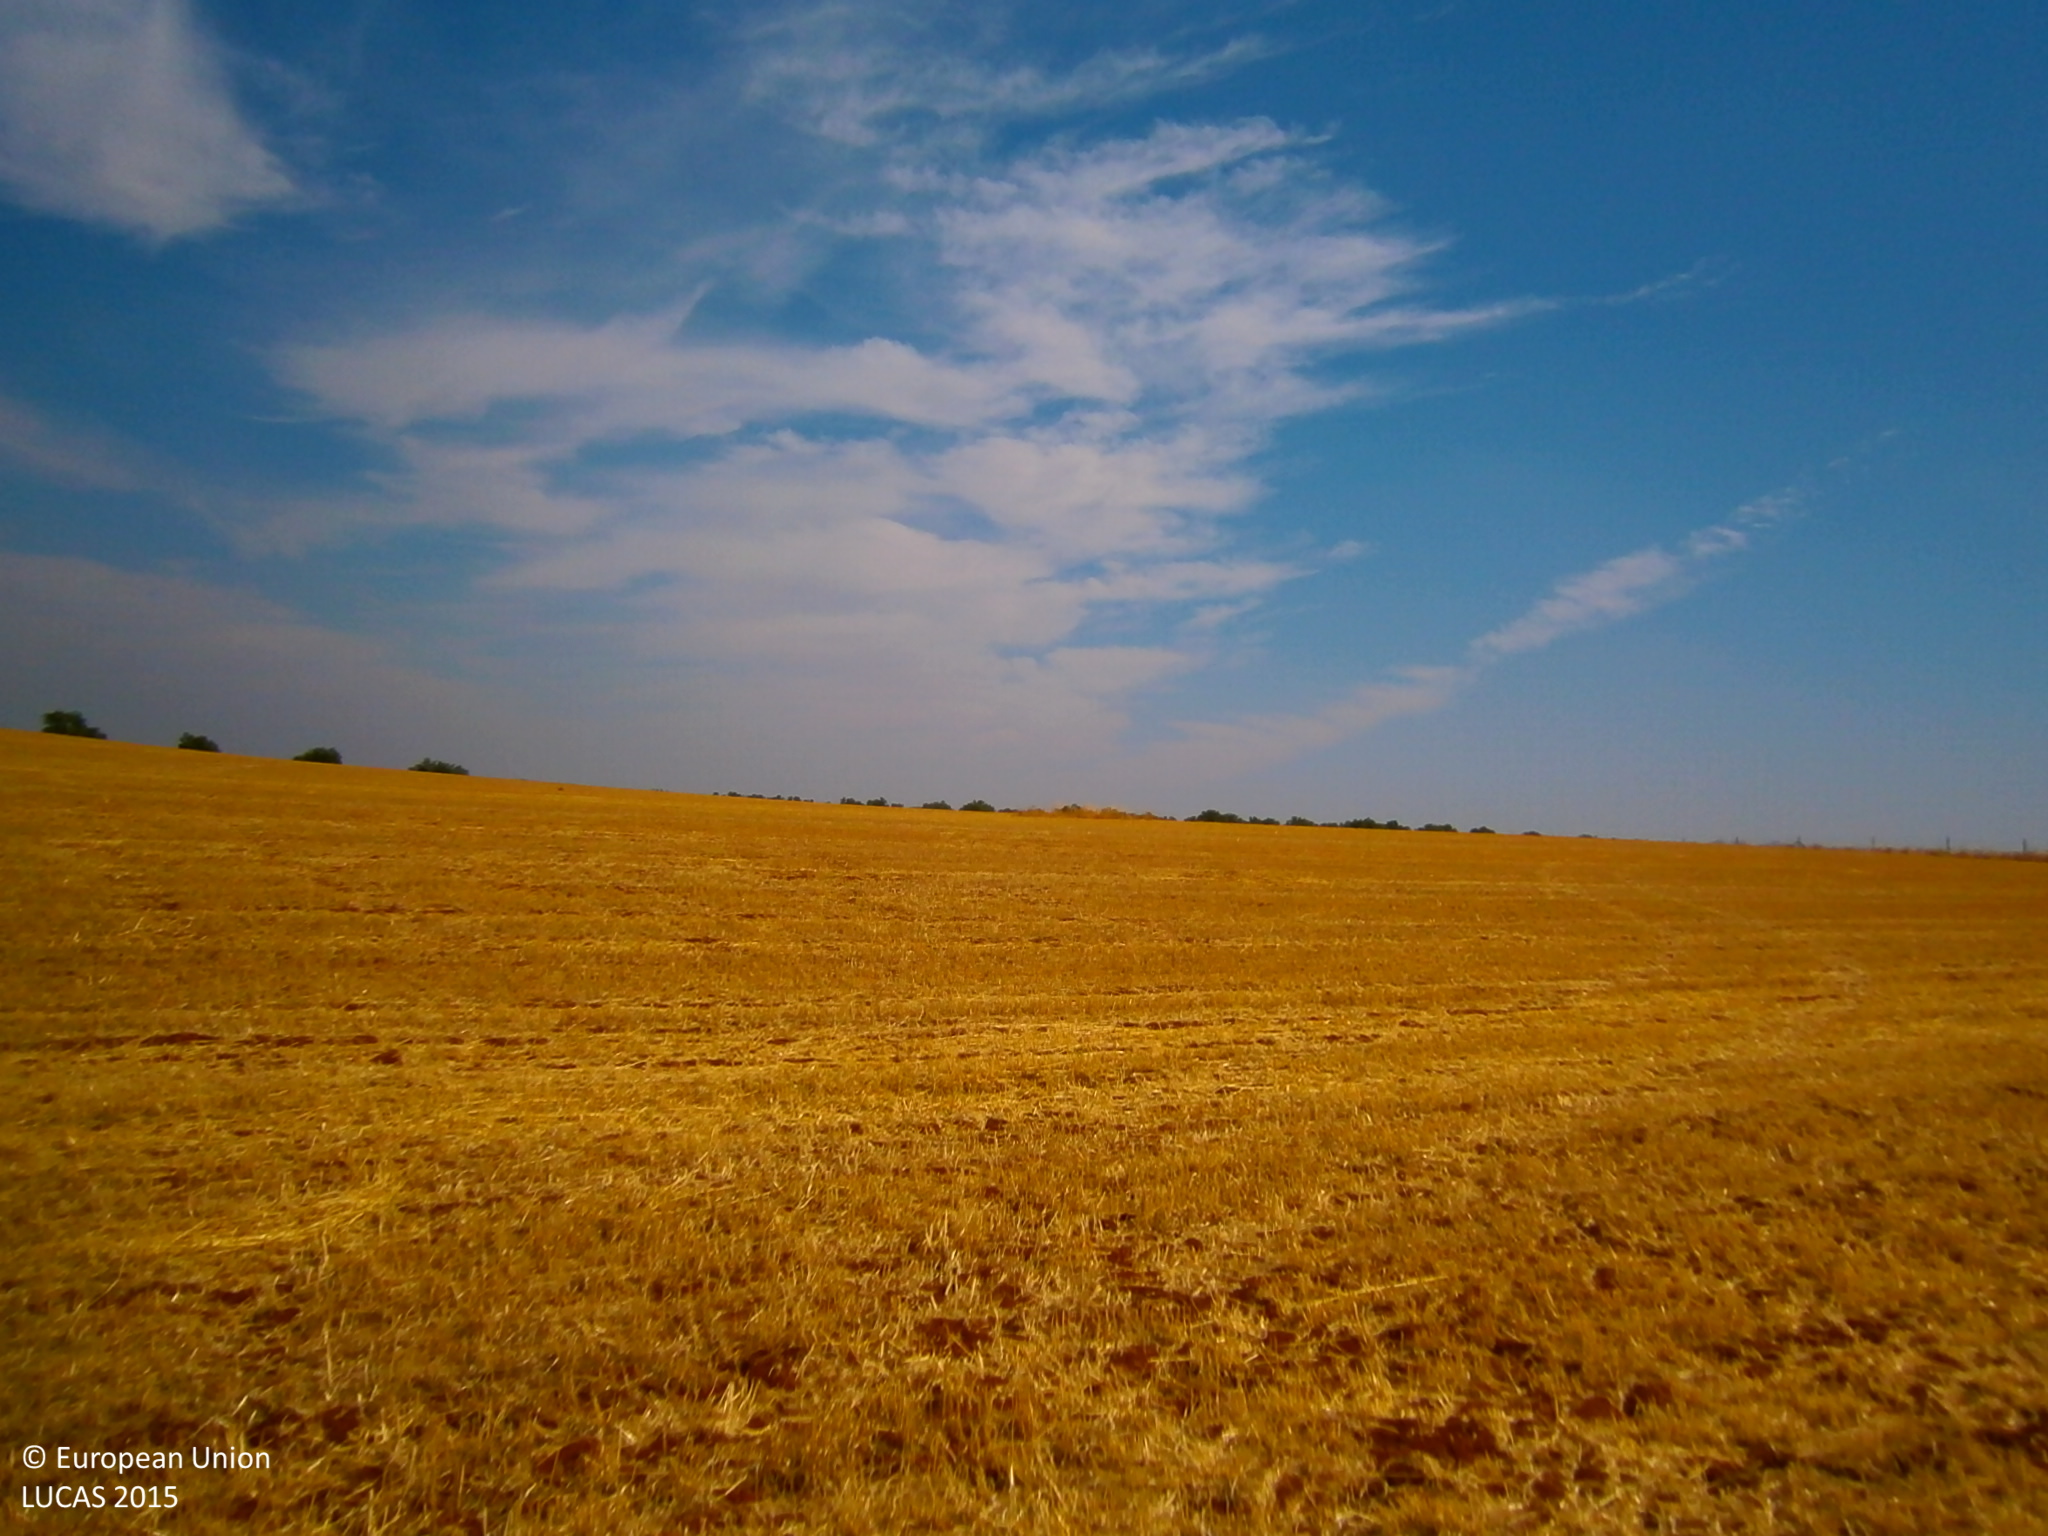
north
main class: Cropland
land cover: Barley
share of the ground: > 75 %
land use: Agriculture (excluding fallow land and kitchen gardens)
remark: Harvested field
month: July
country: ES
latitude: 38.7483
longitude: -6.9227
